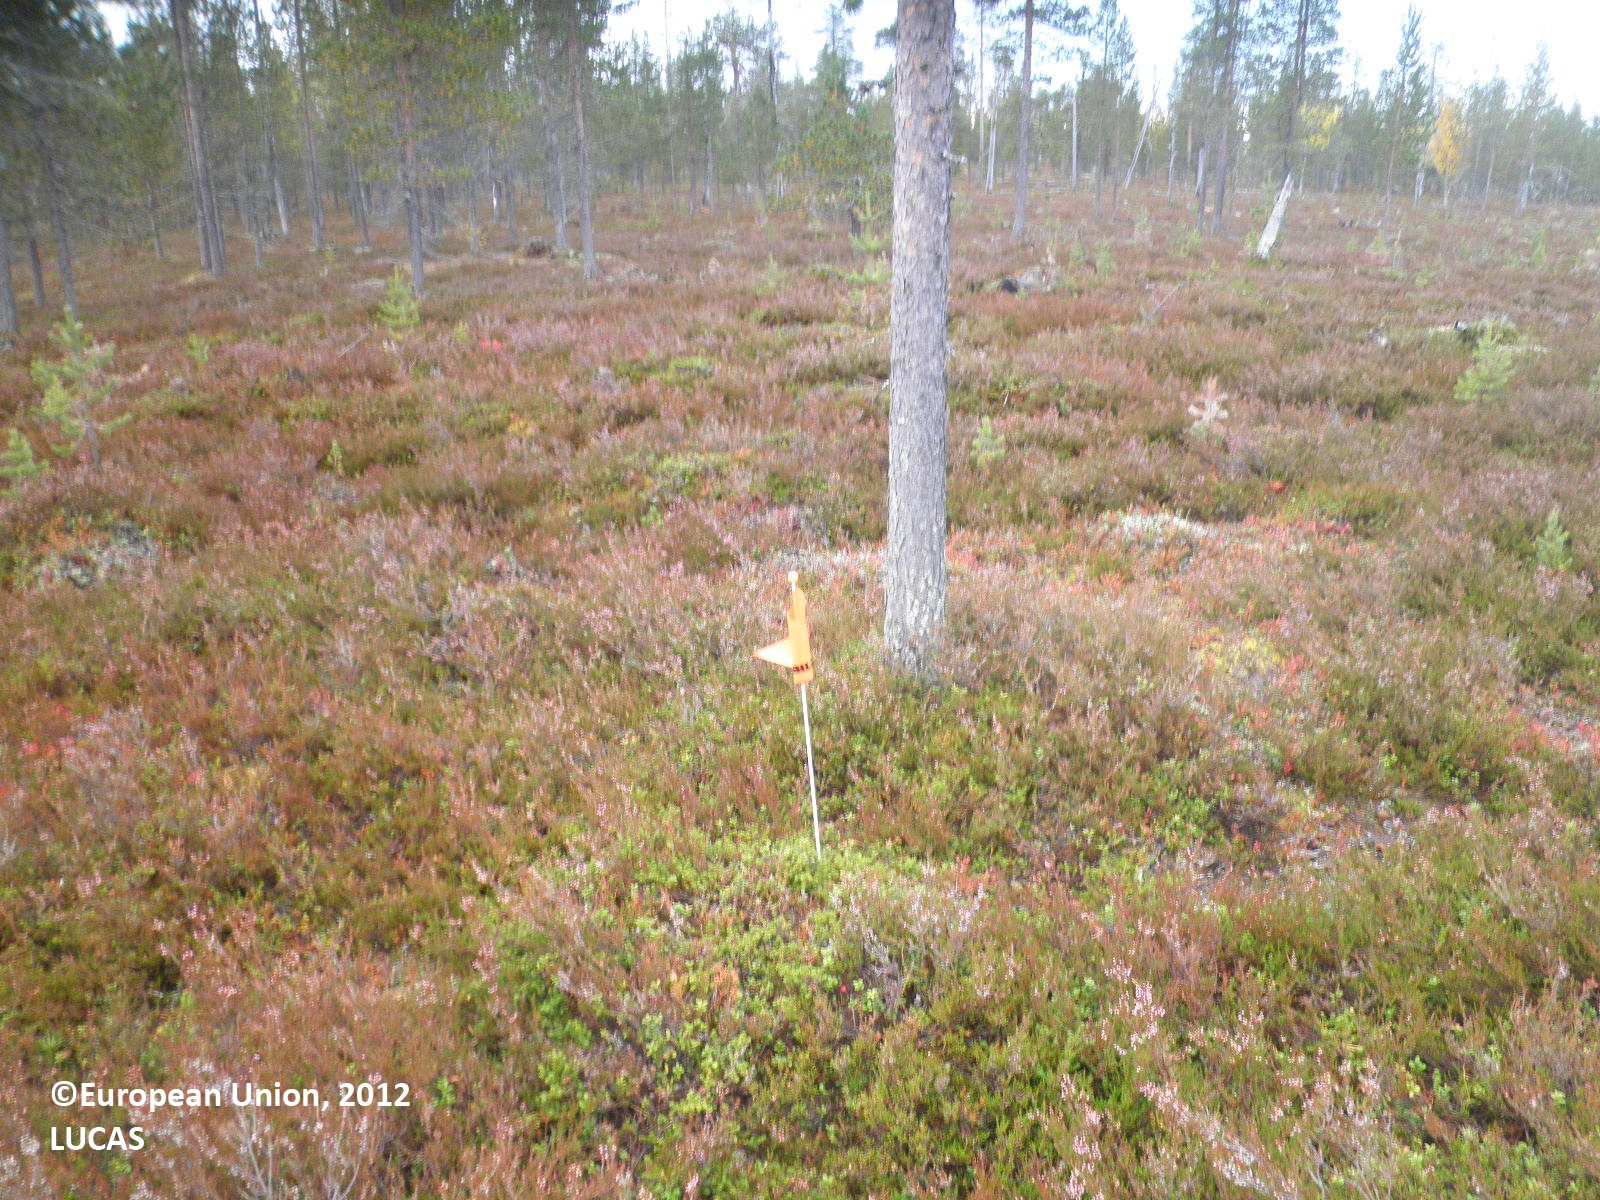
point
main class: Shrubland
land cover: Shrubland with sparse tree cover
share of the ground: > 75 %
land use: Forestry
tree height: > 5 m
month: September
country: FI
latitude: 67.7145
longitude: 28.4846
